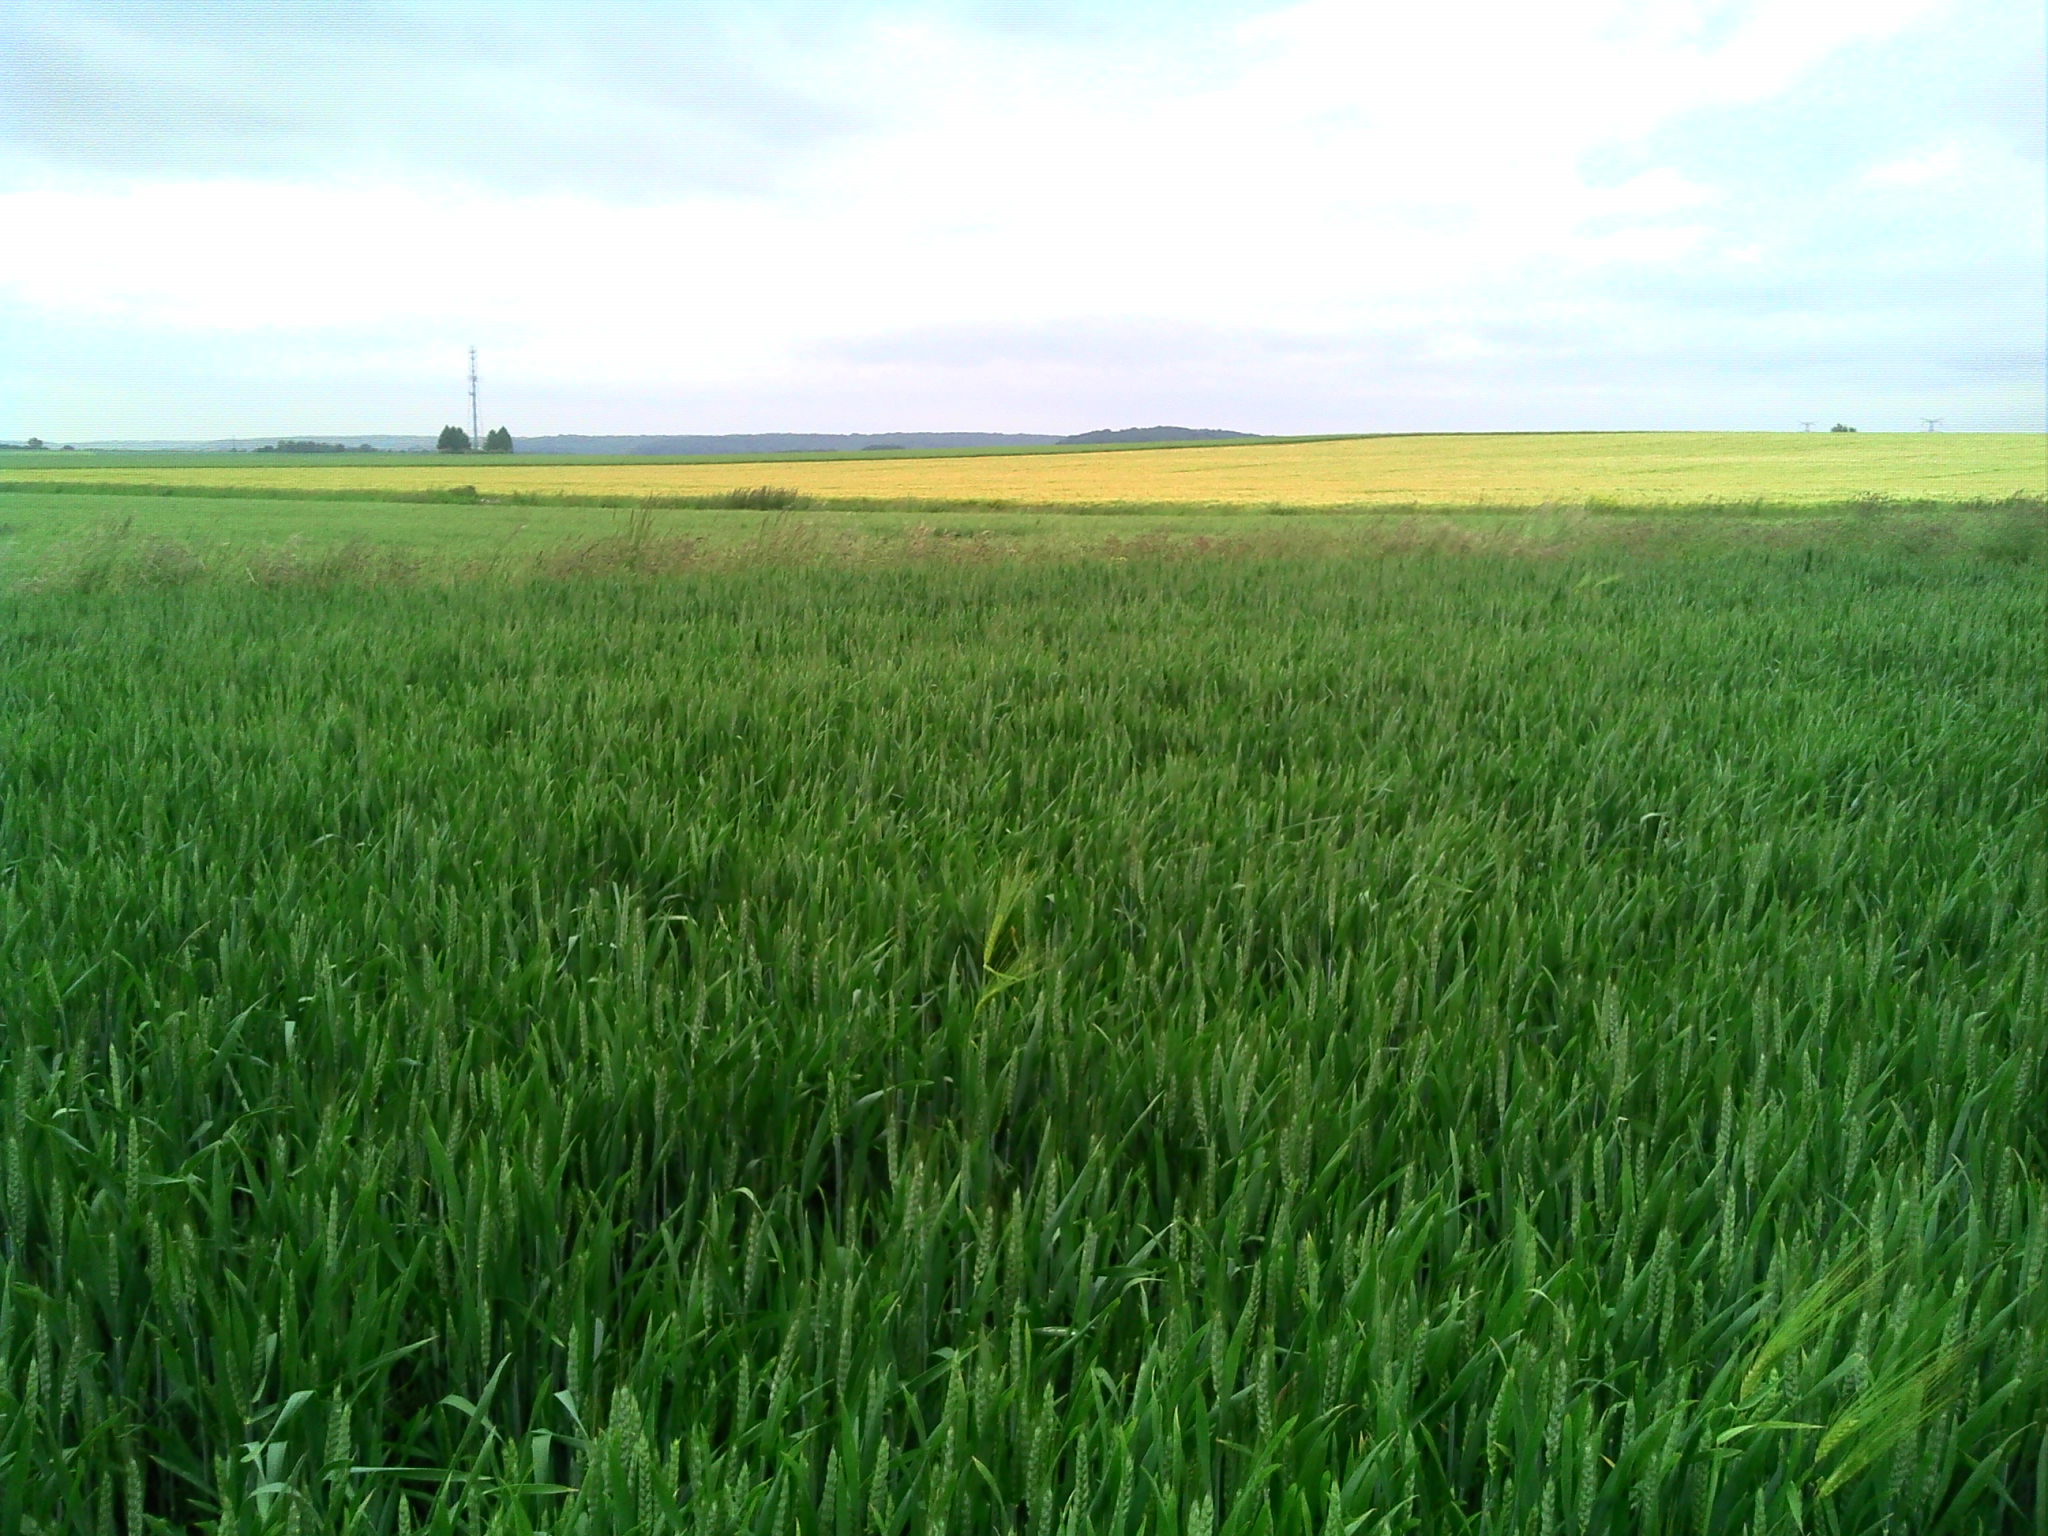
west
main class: Cropland
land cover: Common wheat
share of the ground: > 75 %
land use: Agriculture (excluding fallow land and kitchen gardens)
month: June
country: FR
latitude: 49.6395
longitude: 3.2201
